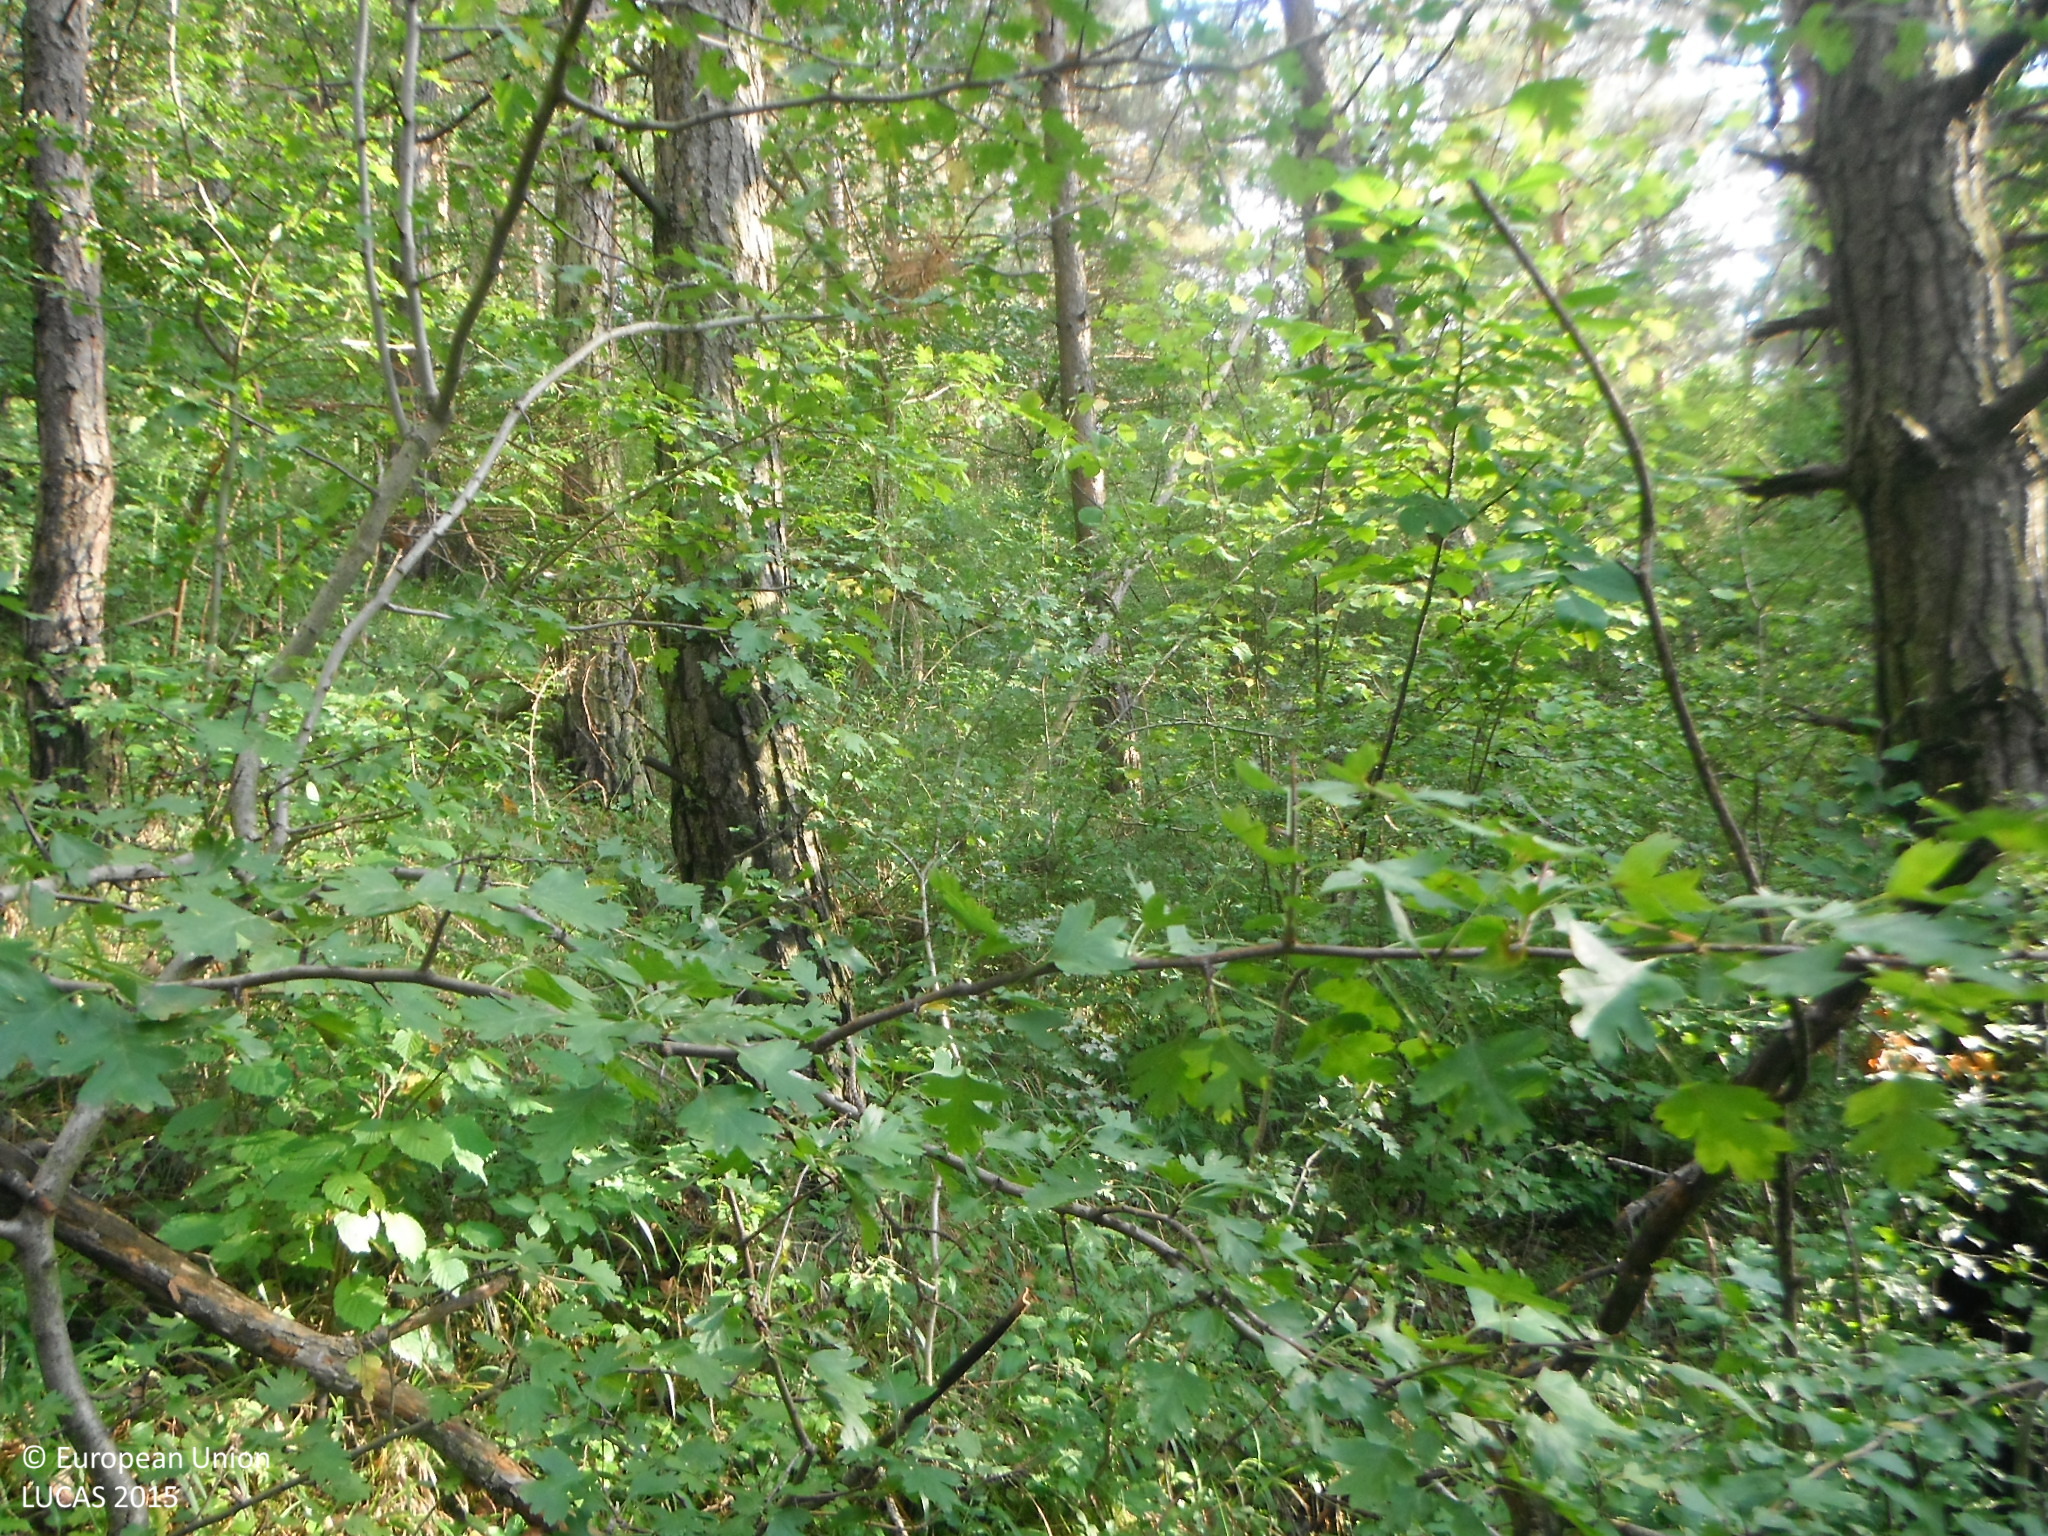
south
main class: Woodland
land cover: Pine dominated coniferous woodland
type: hemiboreal forest and nemoral coniferous forest and mixed broadleaved-coniferous forest
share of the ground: > 75 %
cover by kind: coniferous forest trees 90 %, broadleaved forest trees 10 %
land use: Forestry
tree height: > 5 m
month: August
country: SK
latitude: 48.8276
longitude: 18.3667
